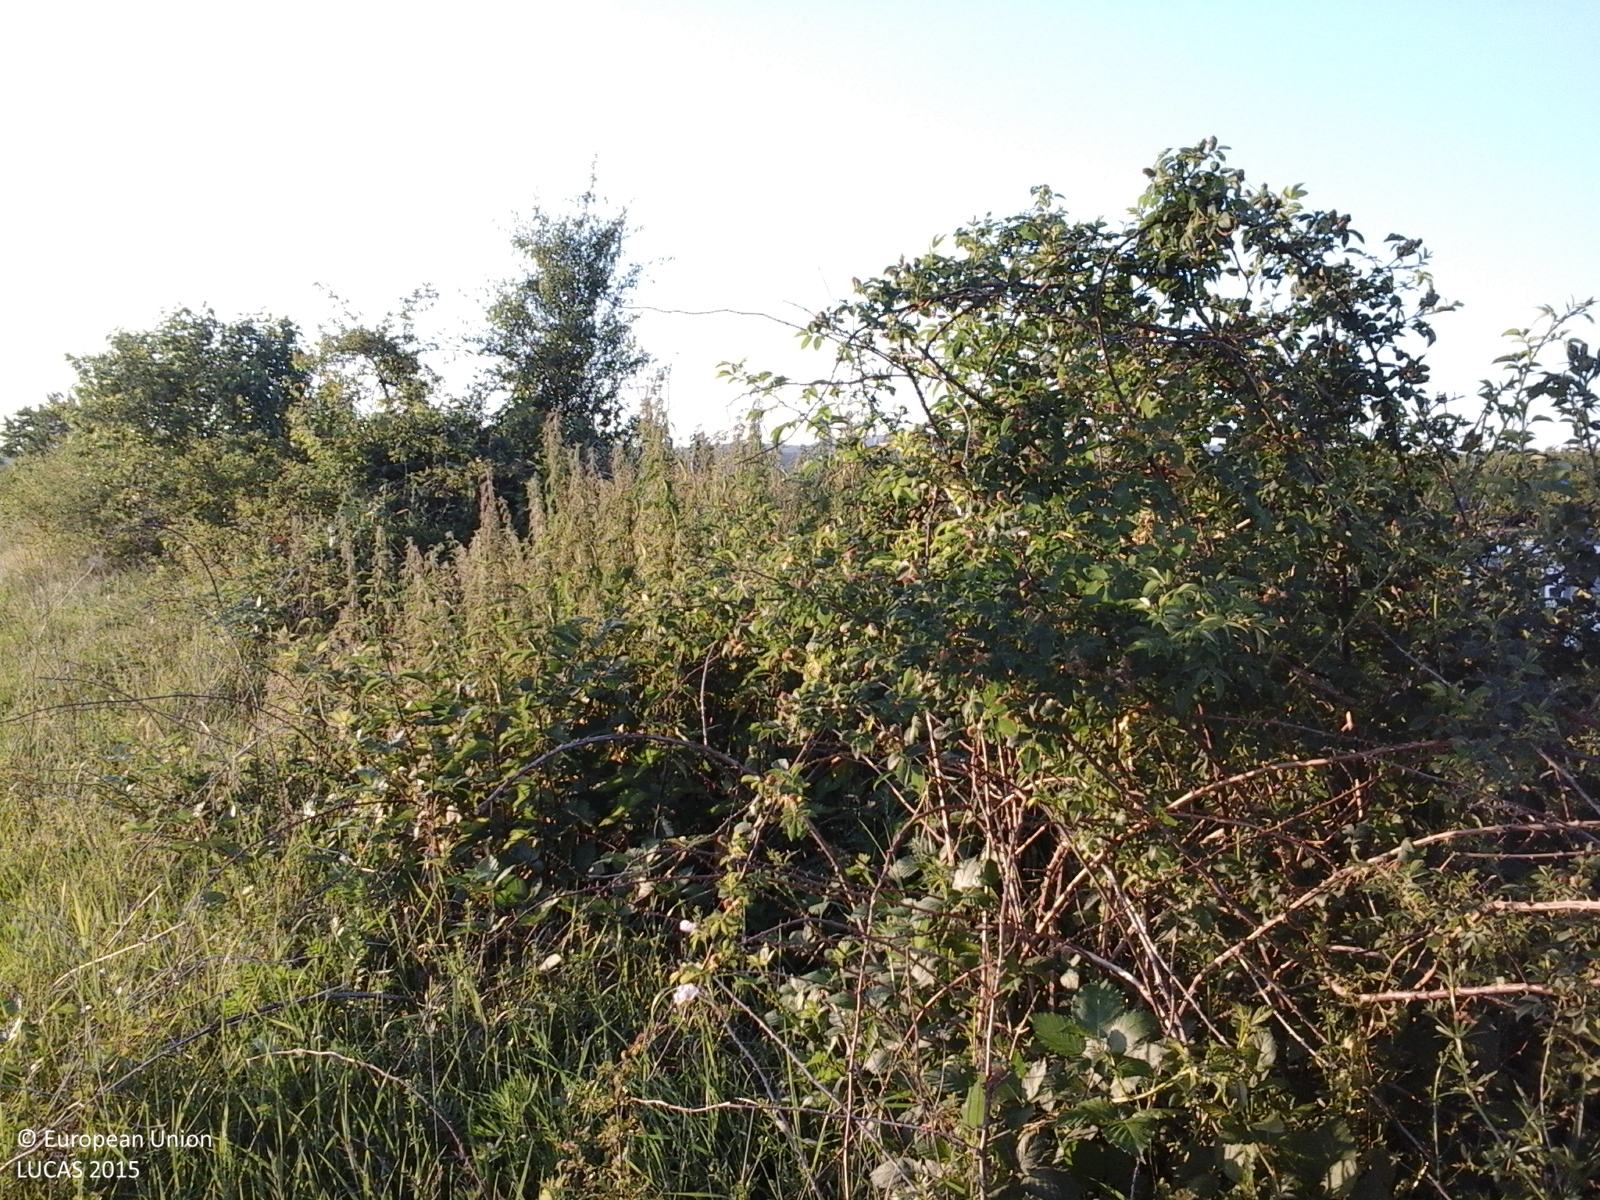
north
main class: Grassland
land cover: Grassland without tree/shrub cover
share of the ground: > 75 %
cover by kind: herbaceous plants 100 %
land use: Agriculture (excluding fallow land and kitchen gardens)
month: June
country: RO
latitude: 45.0732
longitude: 25.8169
